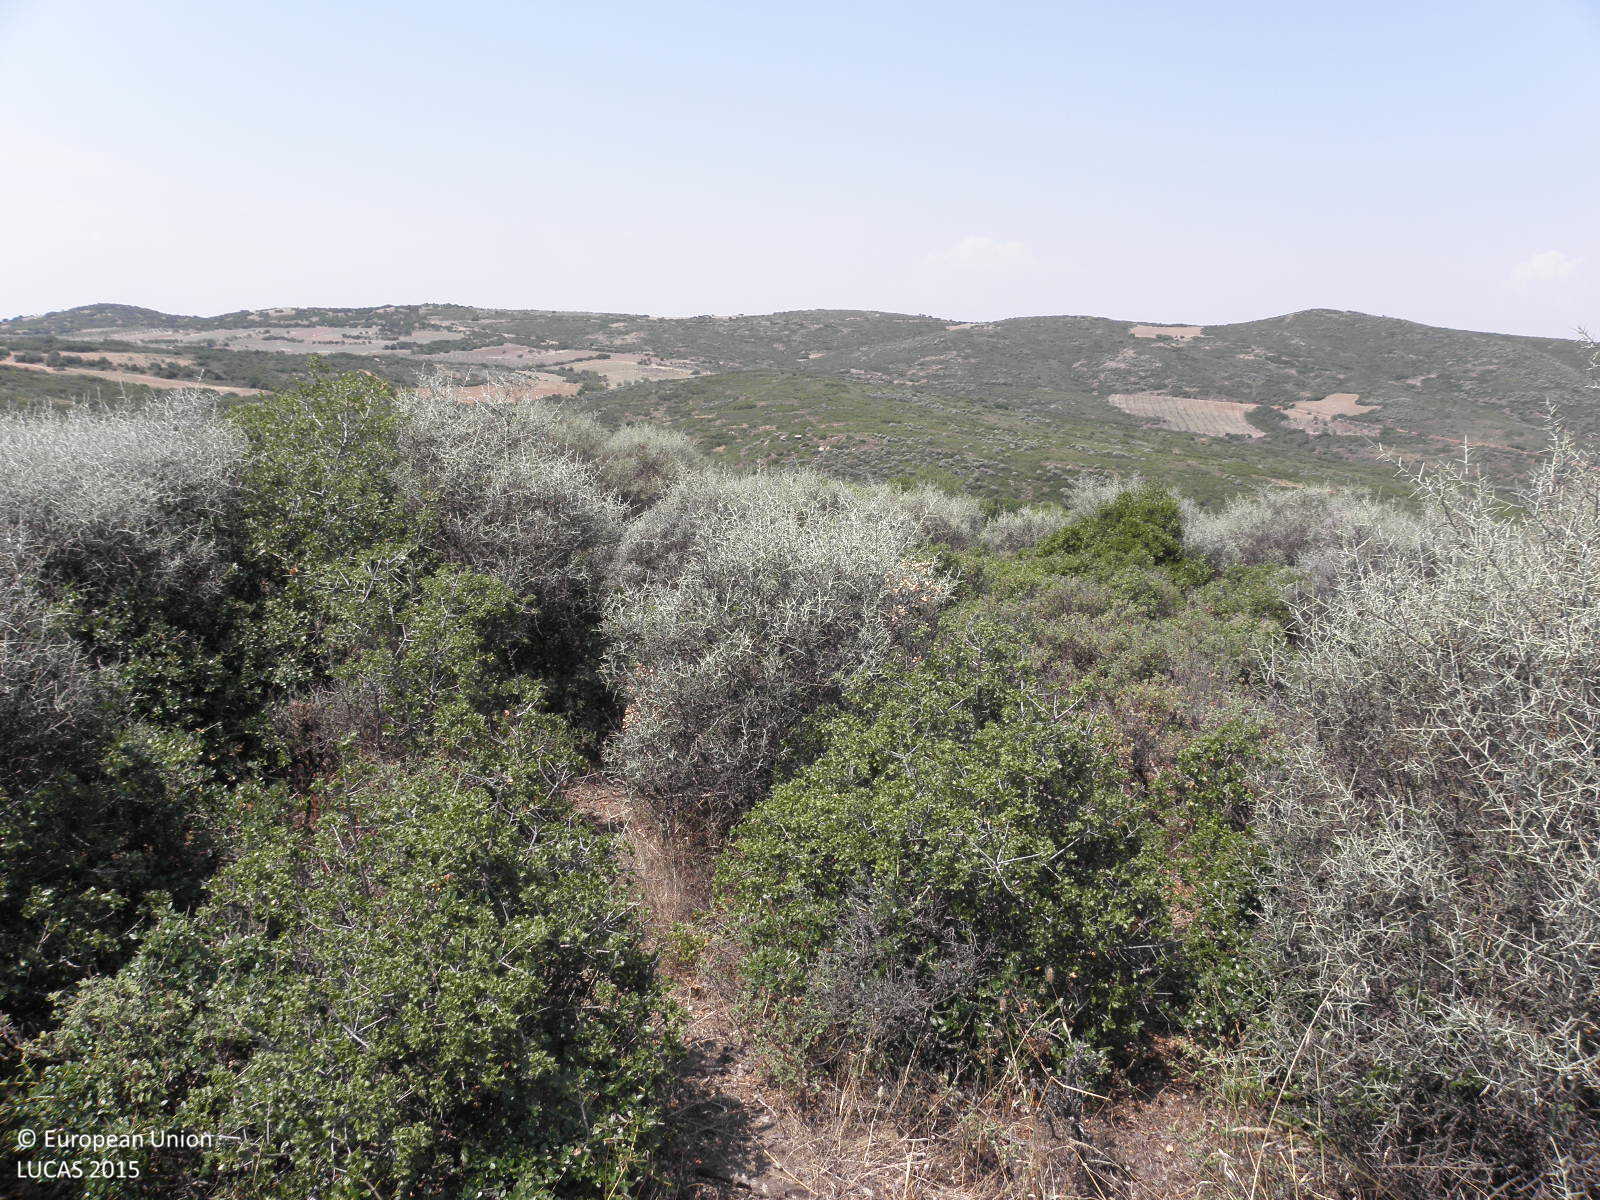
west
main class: Shrubland
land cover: Shrubland without tree cover
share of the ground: > 75 %
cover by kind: shrubs 90 %, herbaceous plants 10 %
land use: Agriculture (excluding fallow land and kitchen gardens)
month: August
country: GR
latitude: 39.6181
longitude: 22.7245
